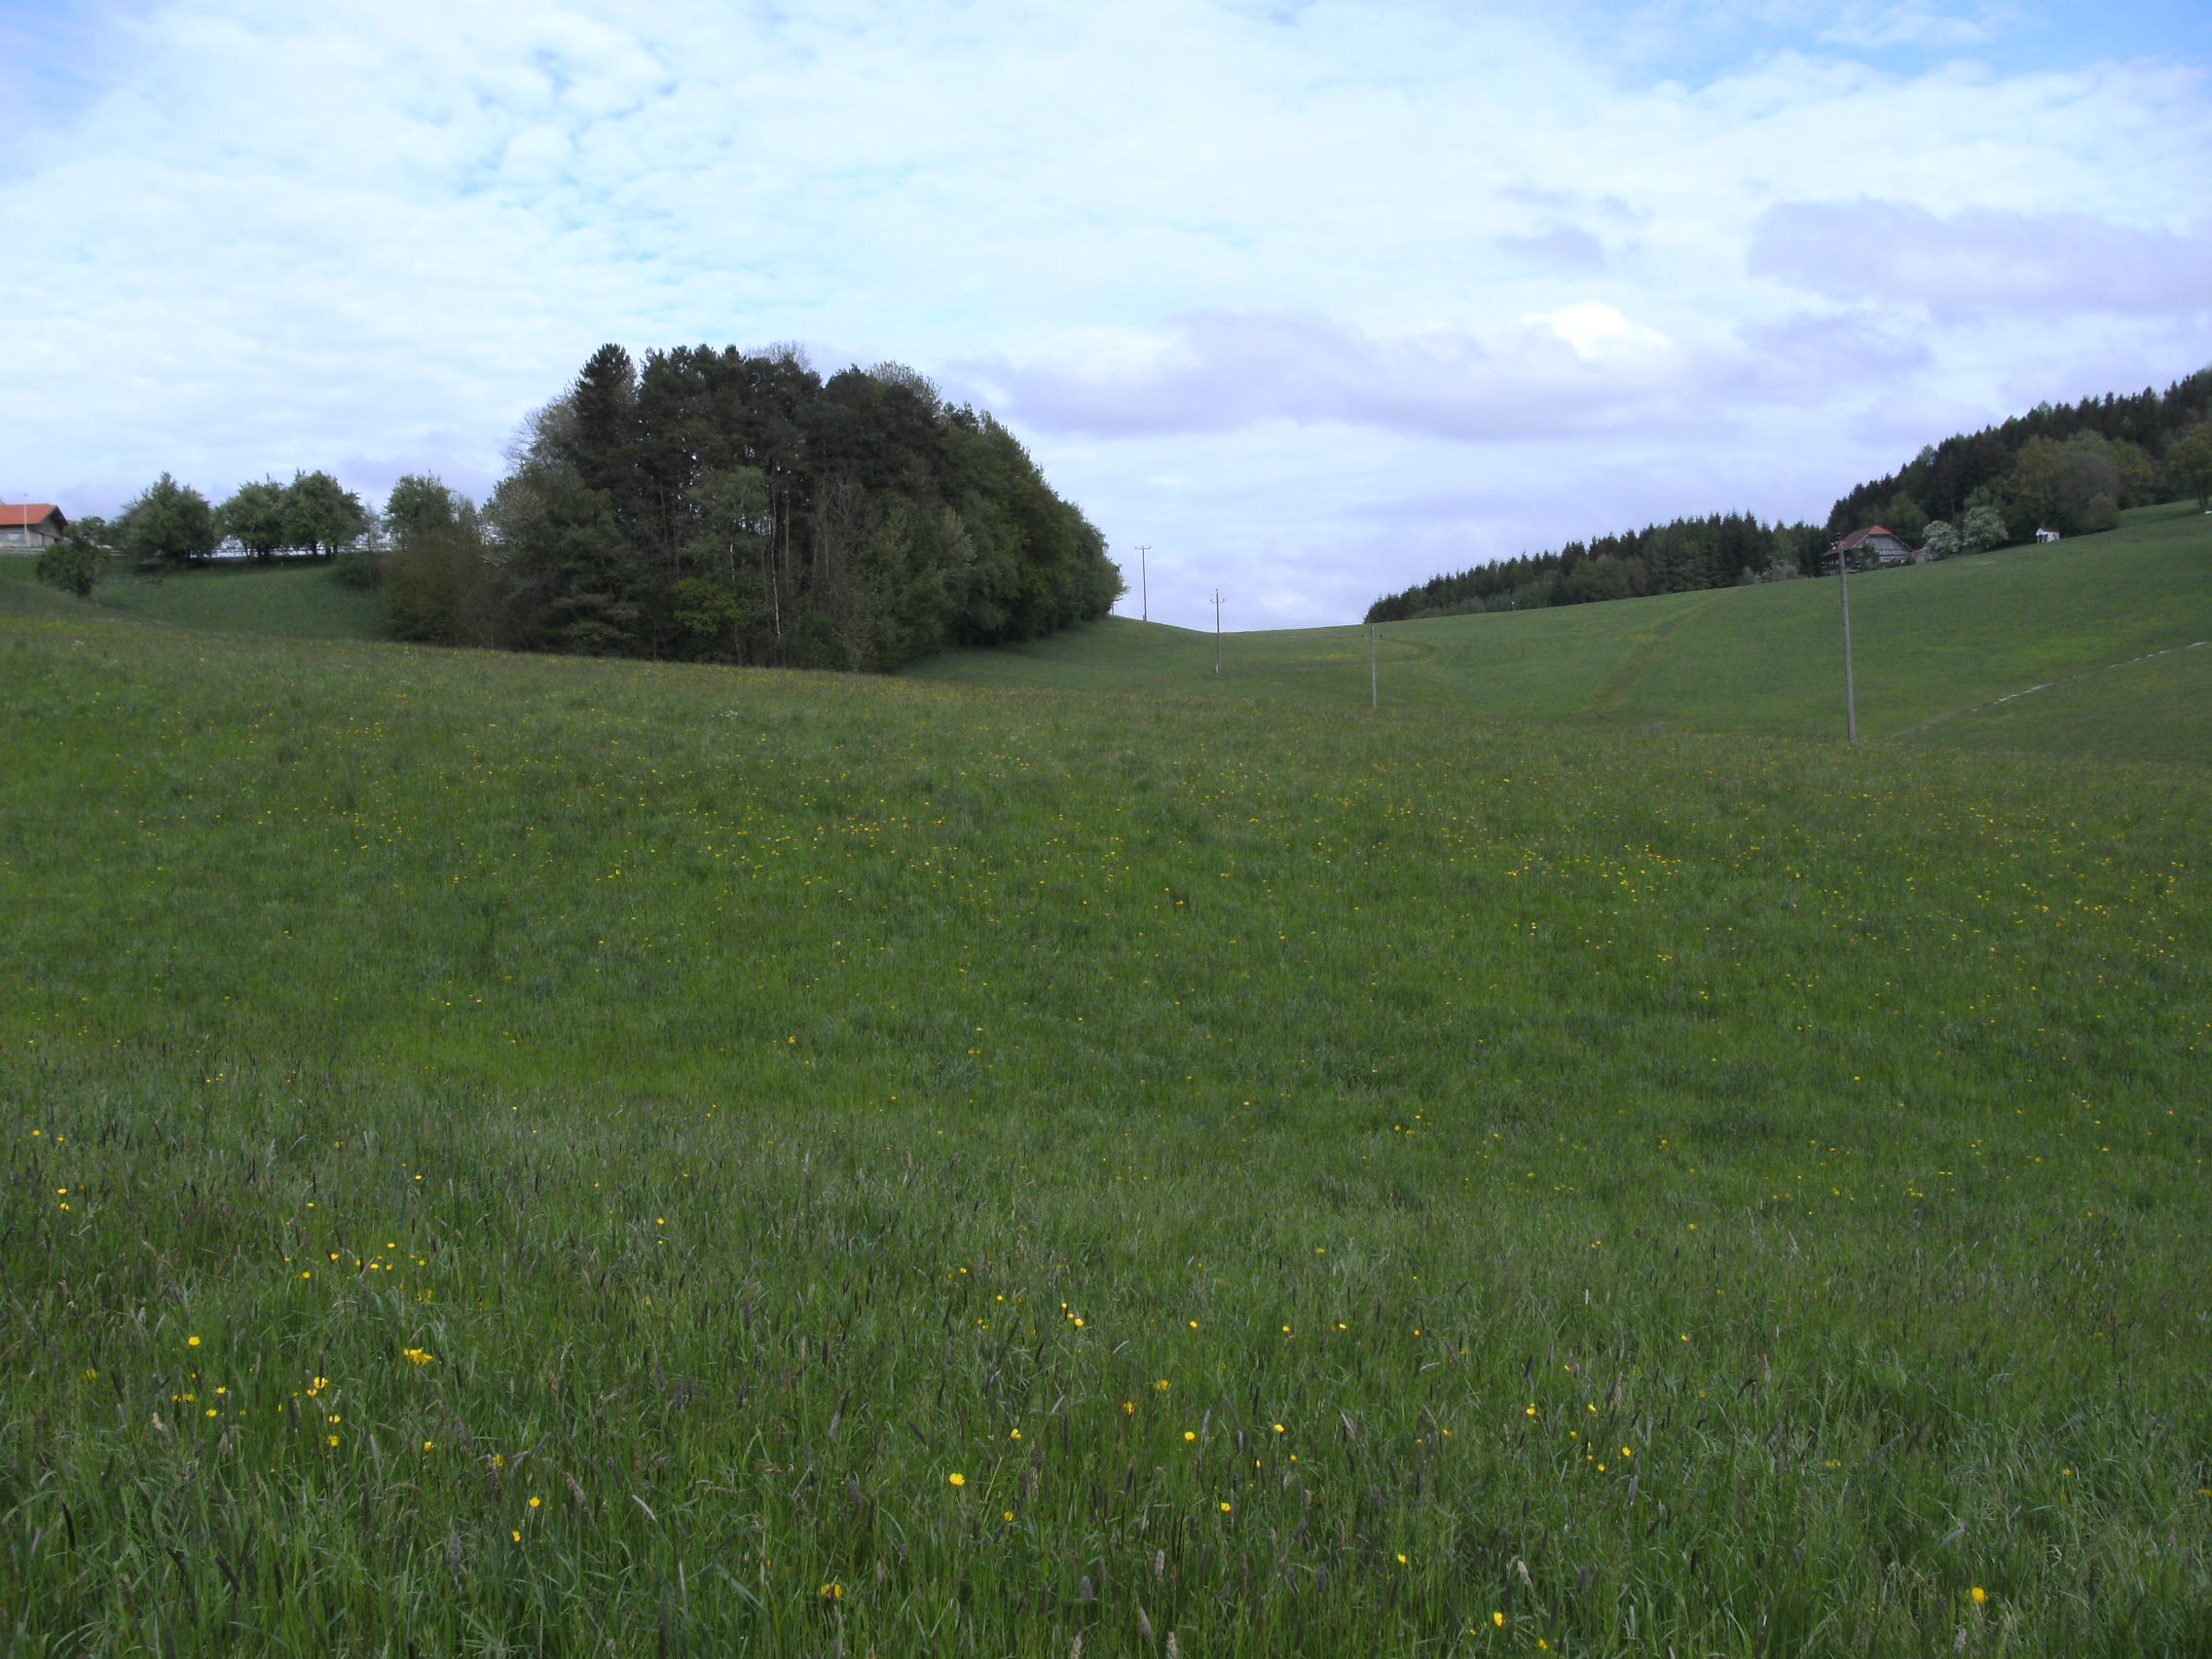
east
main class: Grassland
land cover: Grassland without tree/shrub cover
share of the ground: > 75 %
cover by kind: herbaceous plants 100 %
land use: Agriculture (excluding fallow land and kitchen gardens)
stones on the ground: < 10 %
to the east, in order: Grassland without tree/shrub cover; Tracks; Grassland without tree/shrub cover; Pine dominated mixed woodland
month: May
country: AT
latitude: 48.1360
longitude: 13.3720
